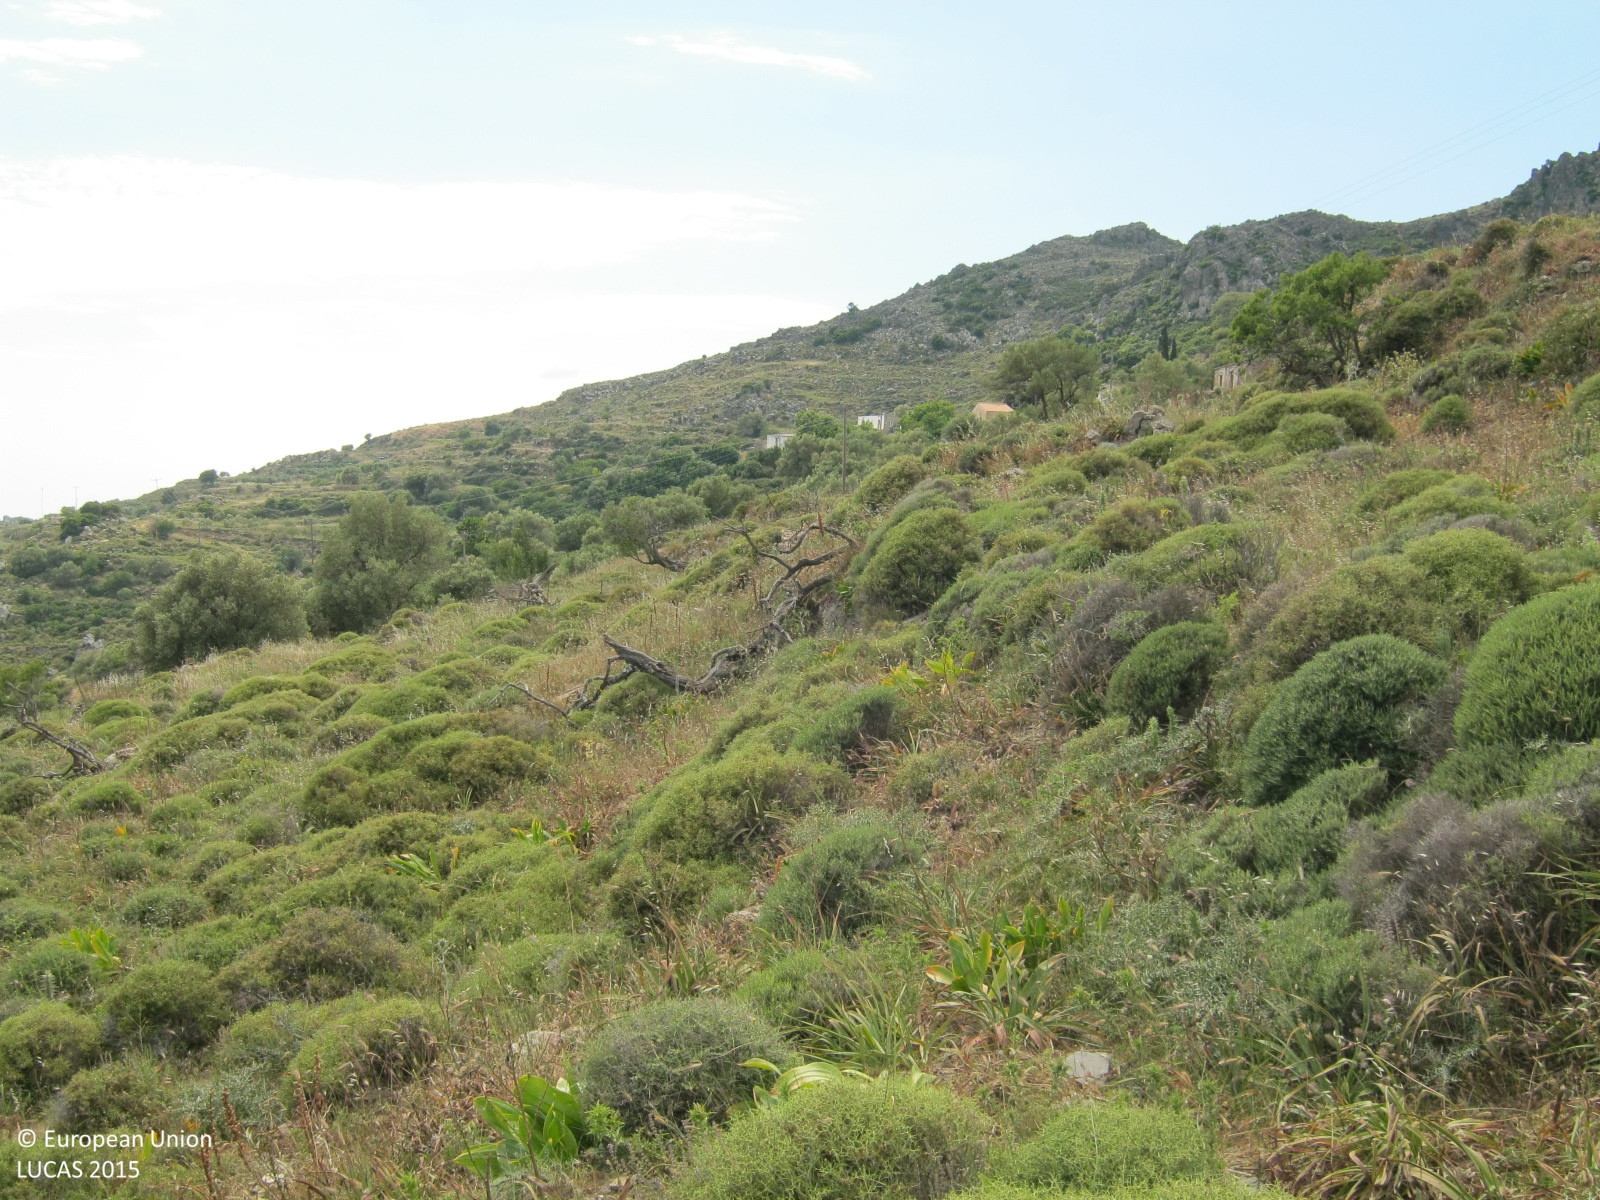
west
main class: Shrubland
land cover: Shrubland with sparse tree cover
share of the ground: > 75 %
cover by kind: shrubs 70 %, unconsolidated bare surface 20 %, broadleaved forest trees 5 %, herbaceous plants 5 %
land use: Agriculture (excluding fallow land and kitchen gardens)
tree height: < 5 m
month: June
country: GR
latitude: 35.2721
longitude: 23.7541
